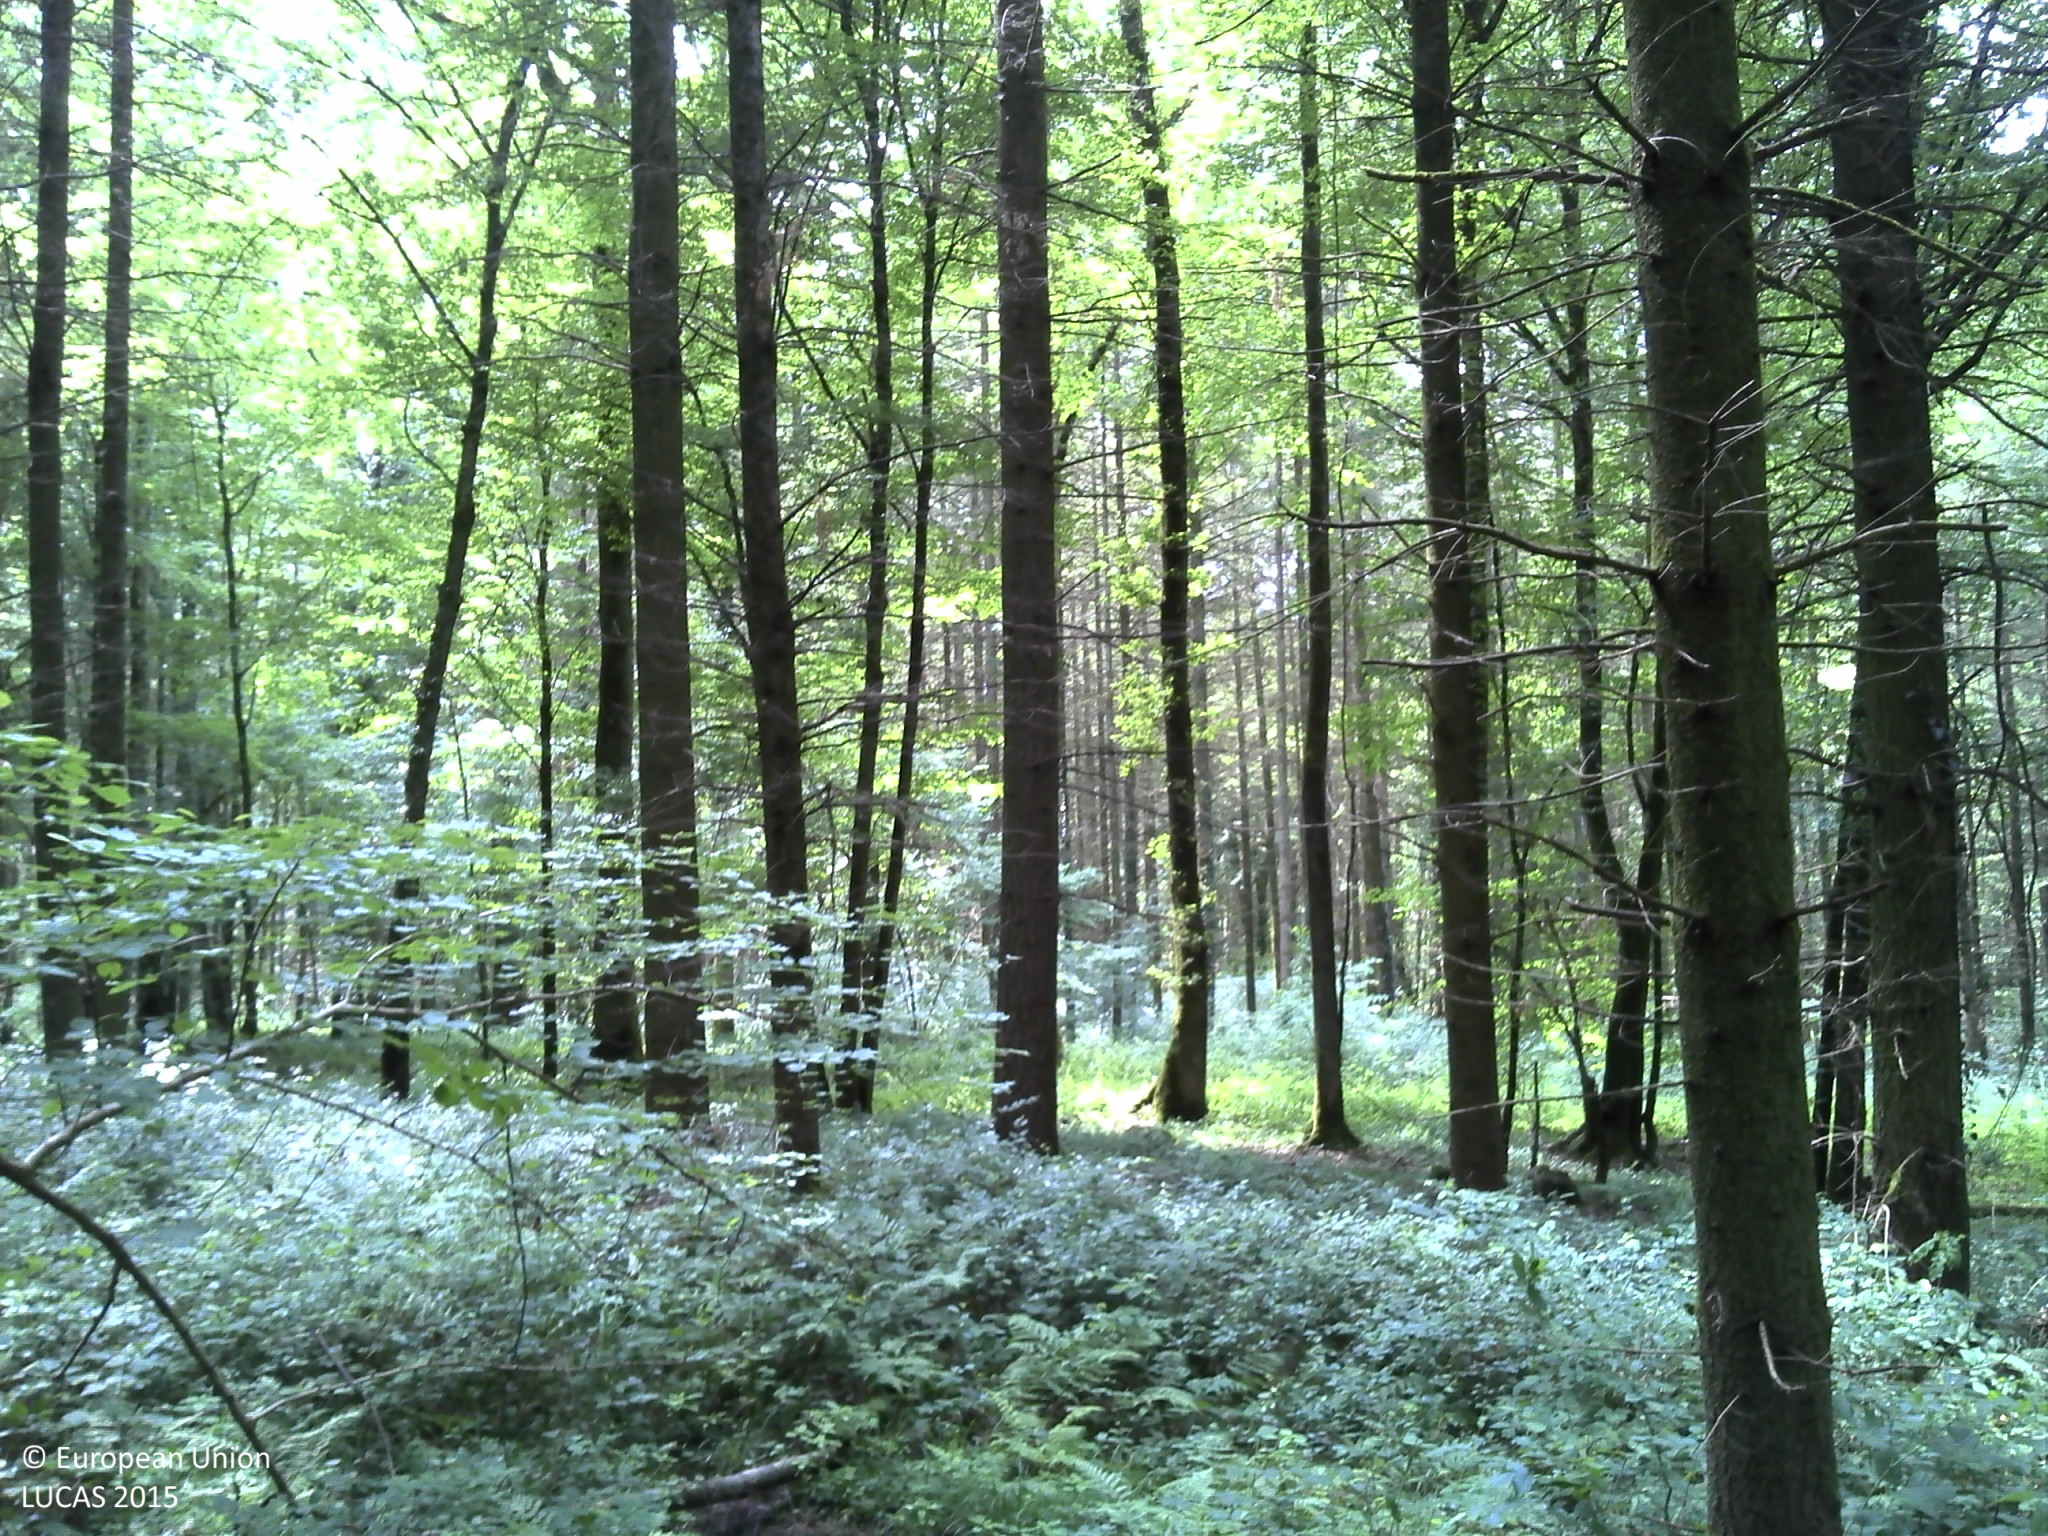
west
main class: Woodland
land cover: Spruce dominated coniferous woodland
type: exotic forest
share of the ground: 50 - 75 %
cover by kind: coniferous forest trees 60 %, herbaceous plants 20 %, broadleaved forest trees 10 %, lichens and mosses 10 %
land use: Forestry
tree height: > 5 m
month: June
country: FR
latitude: 49.3643
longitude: 4.8335
